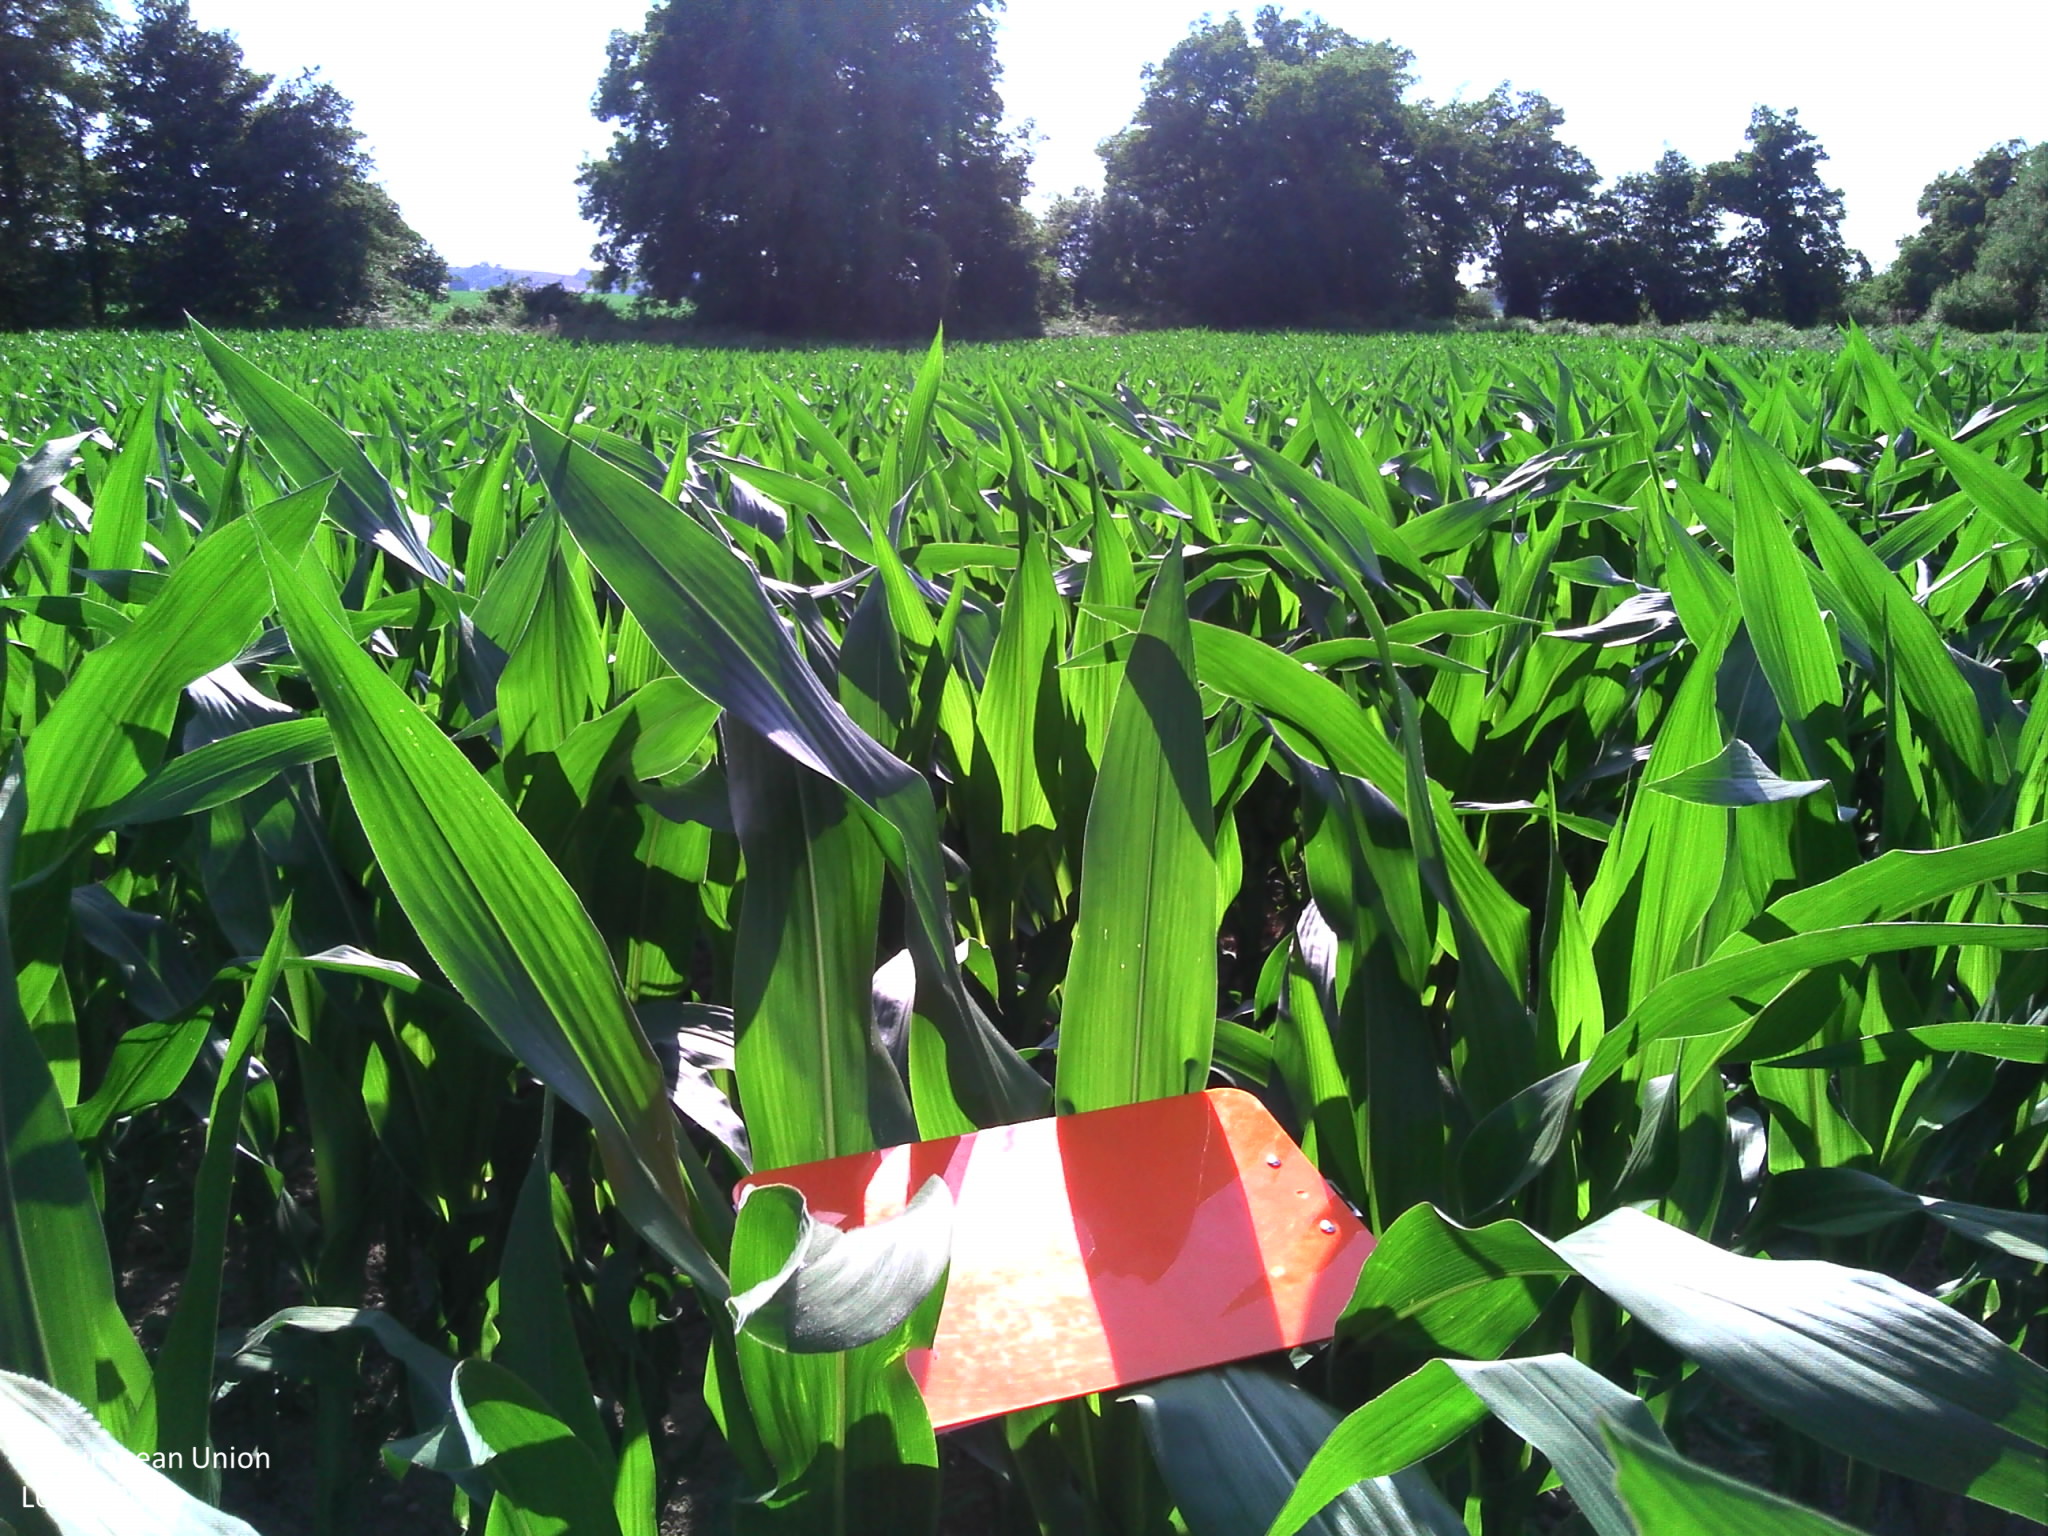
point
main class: Cropland
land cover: Maize
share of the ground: > 75 %
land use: Agriculture (excluding fallow land and kitchen gardens)
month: June
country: FR
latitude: 43.6031
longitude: -0.4531
